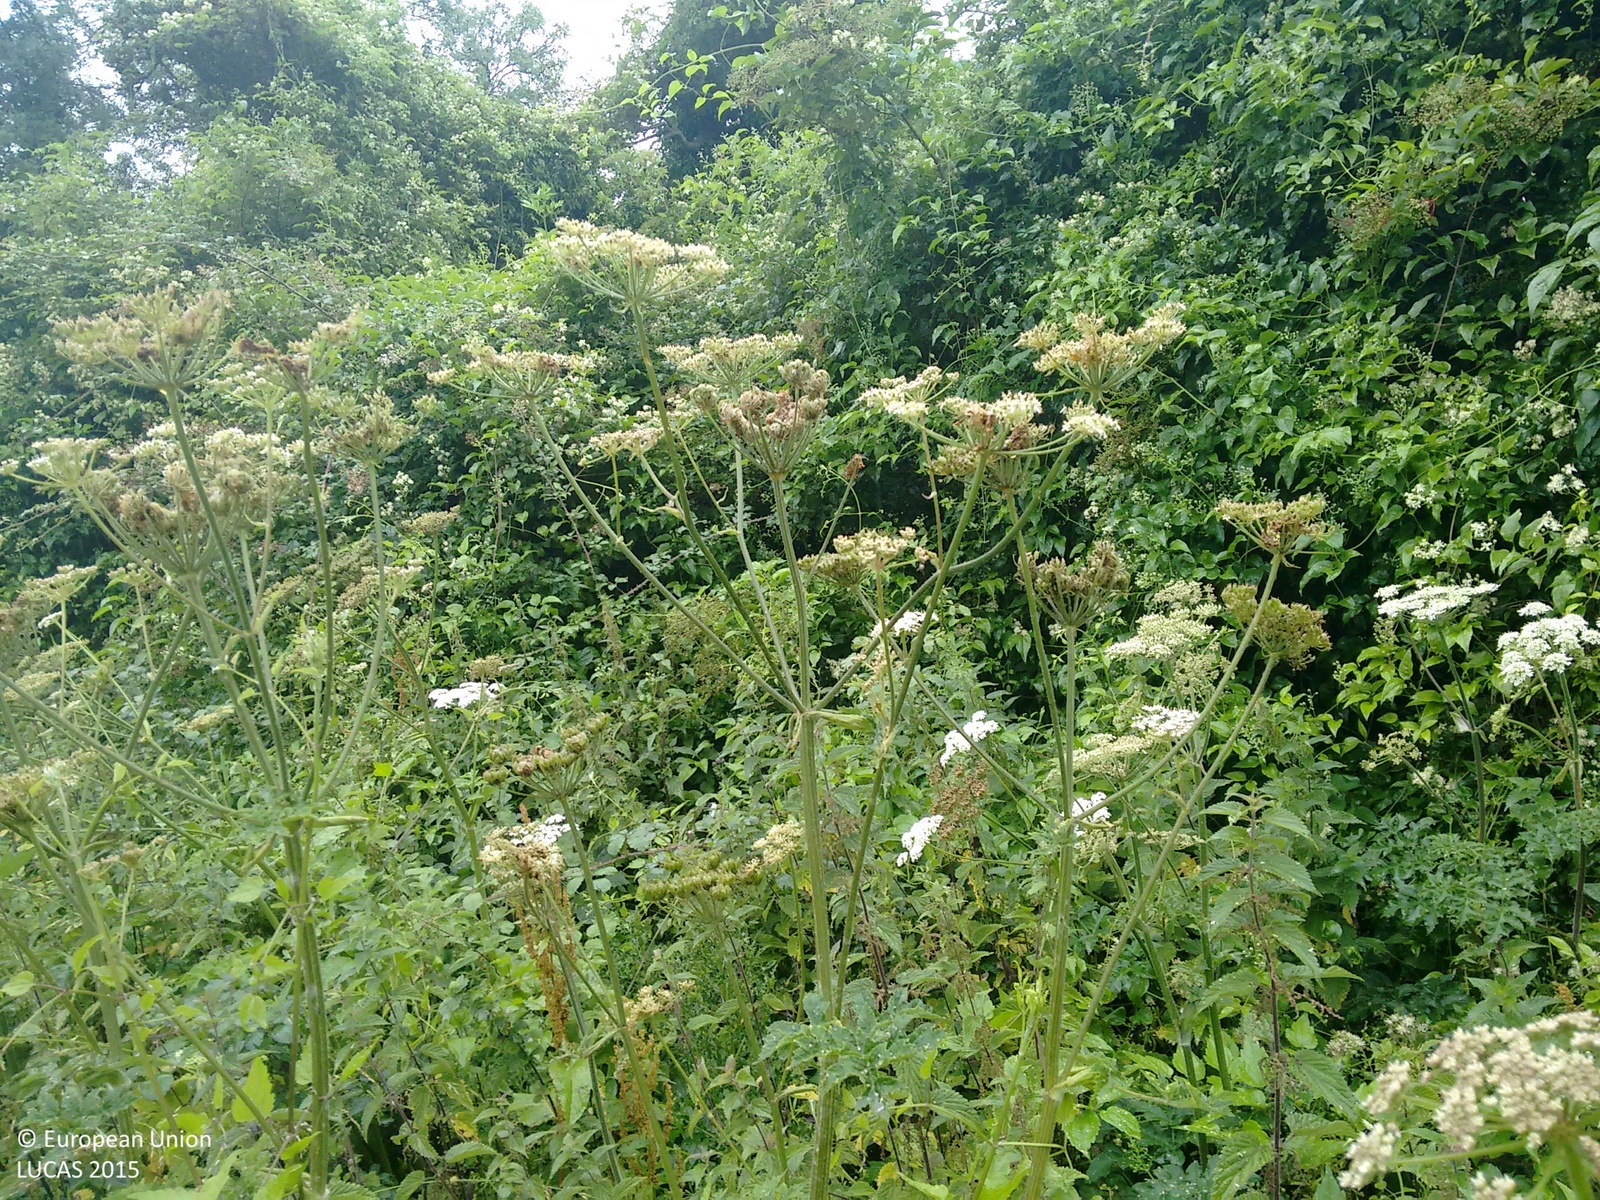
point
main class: Woodland
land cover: Broadleaved woodland
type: mesophytic deciduous forest
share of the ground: > 75 %
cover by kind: broadleaved forest trees 100 %
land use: Agriculture (excluding fallow land and kitchen gardens)
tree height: > 5 m
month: July
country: GB
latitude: 51.0411
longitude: -1.0701
